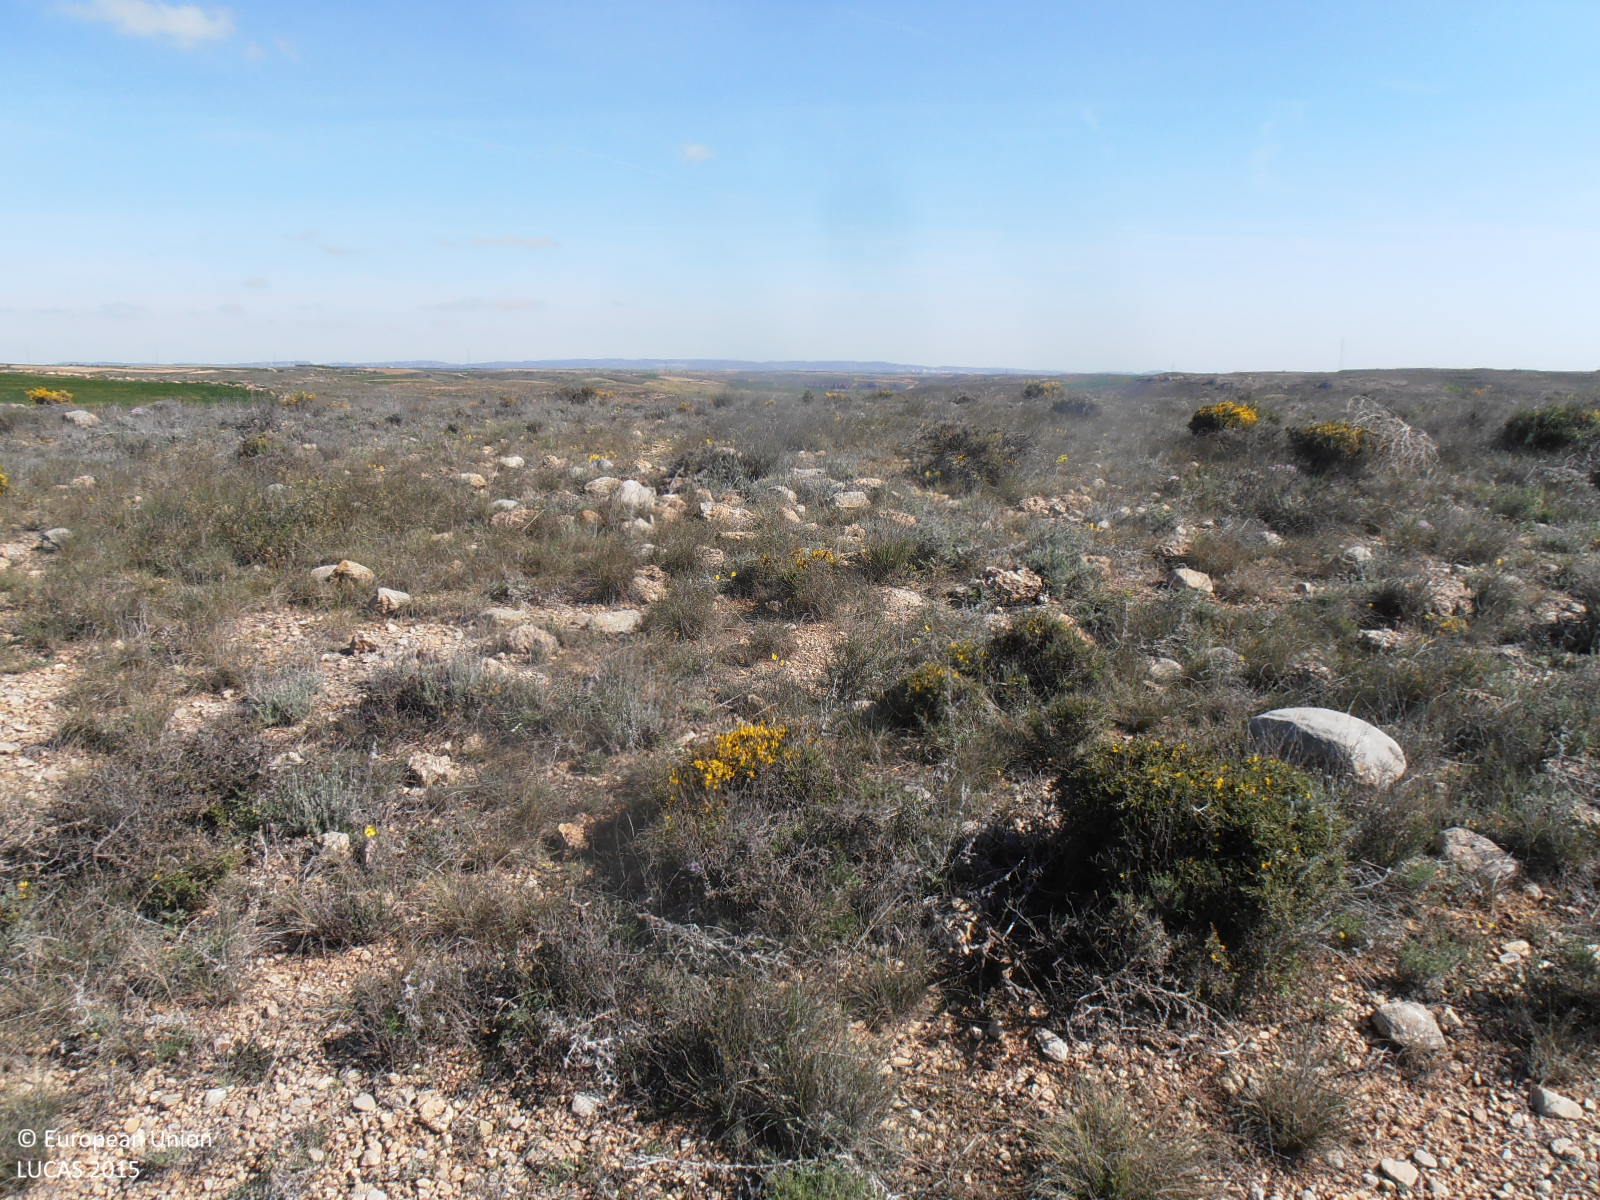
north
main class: Shrubland
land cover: Shrubland without tree cover
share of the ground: 50 - 75 %
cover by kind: consolidated bare surface 50 %, shrubs 40 %, herbaceous plants 10 %
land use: Semi-natural and natural areas not in use
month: April
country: ES
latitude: 41.1663
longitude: -0.9470
